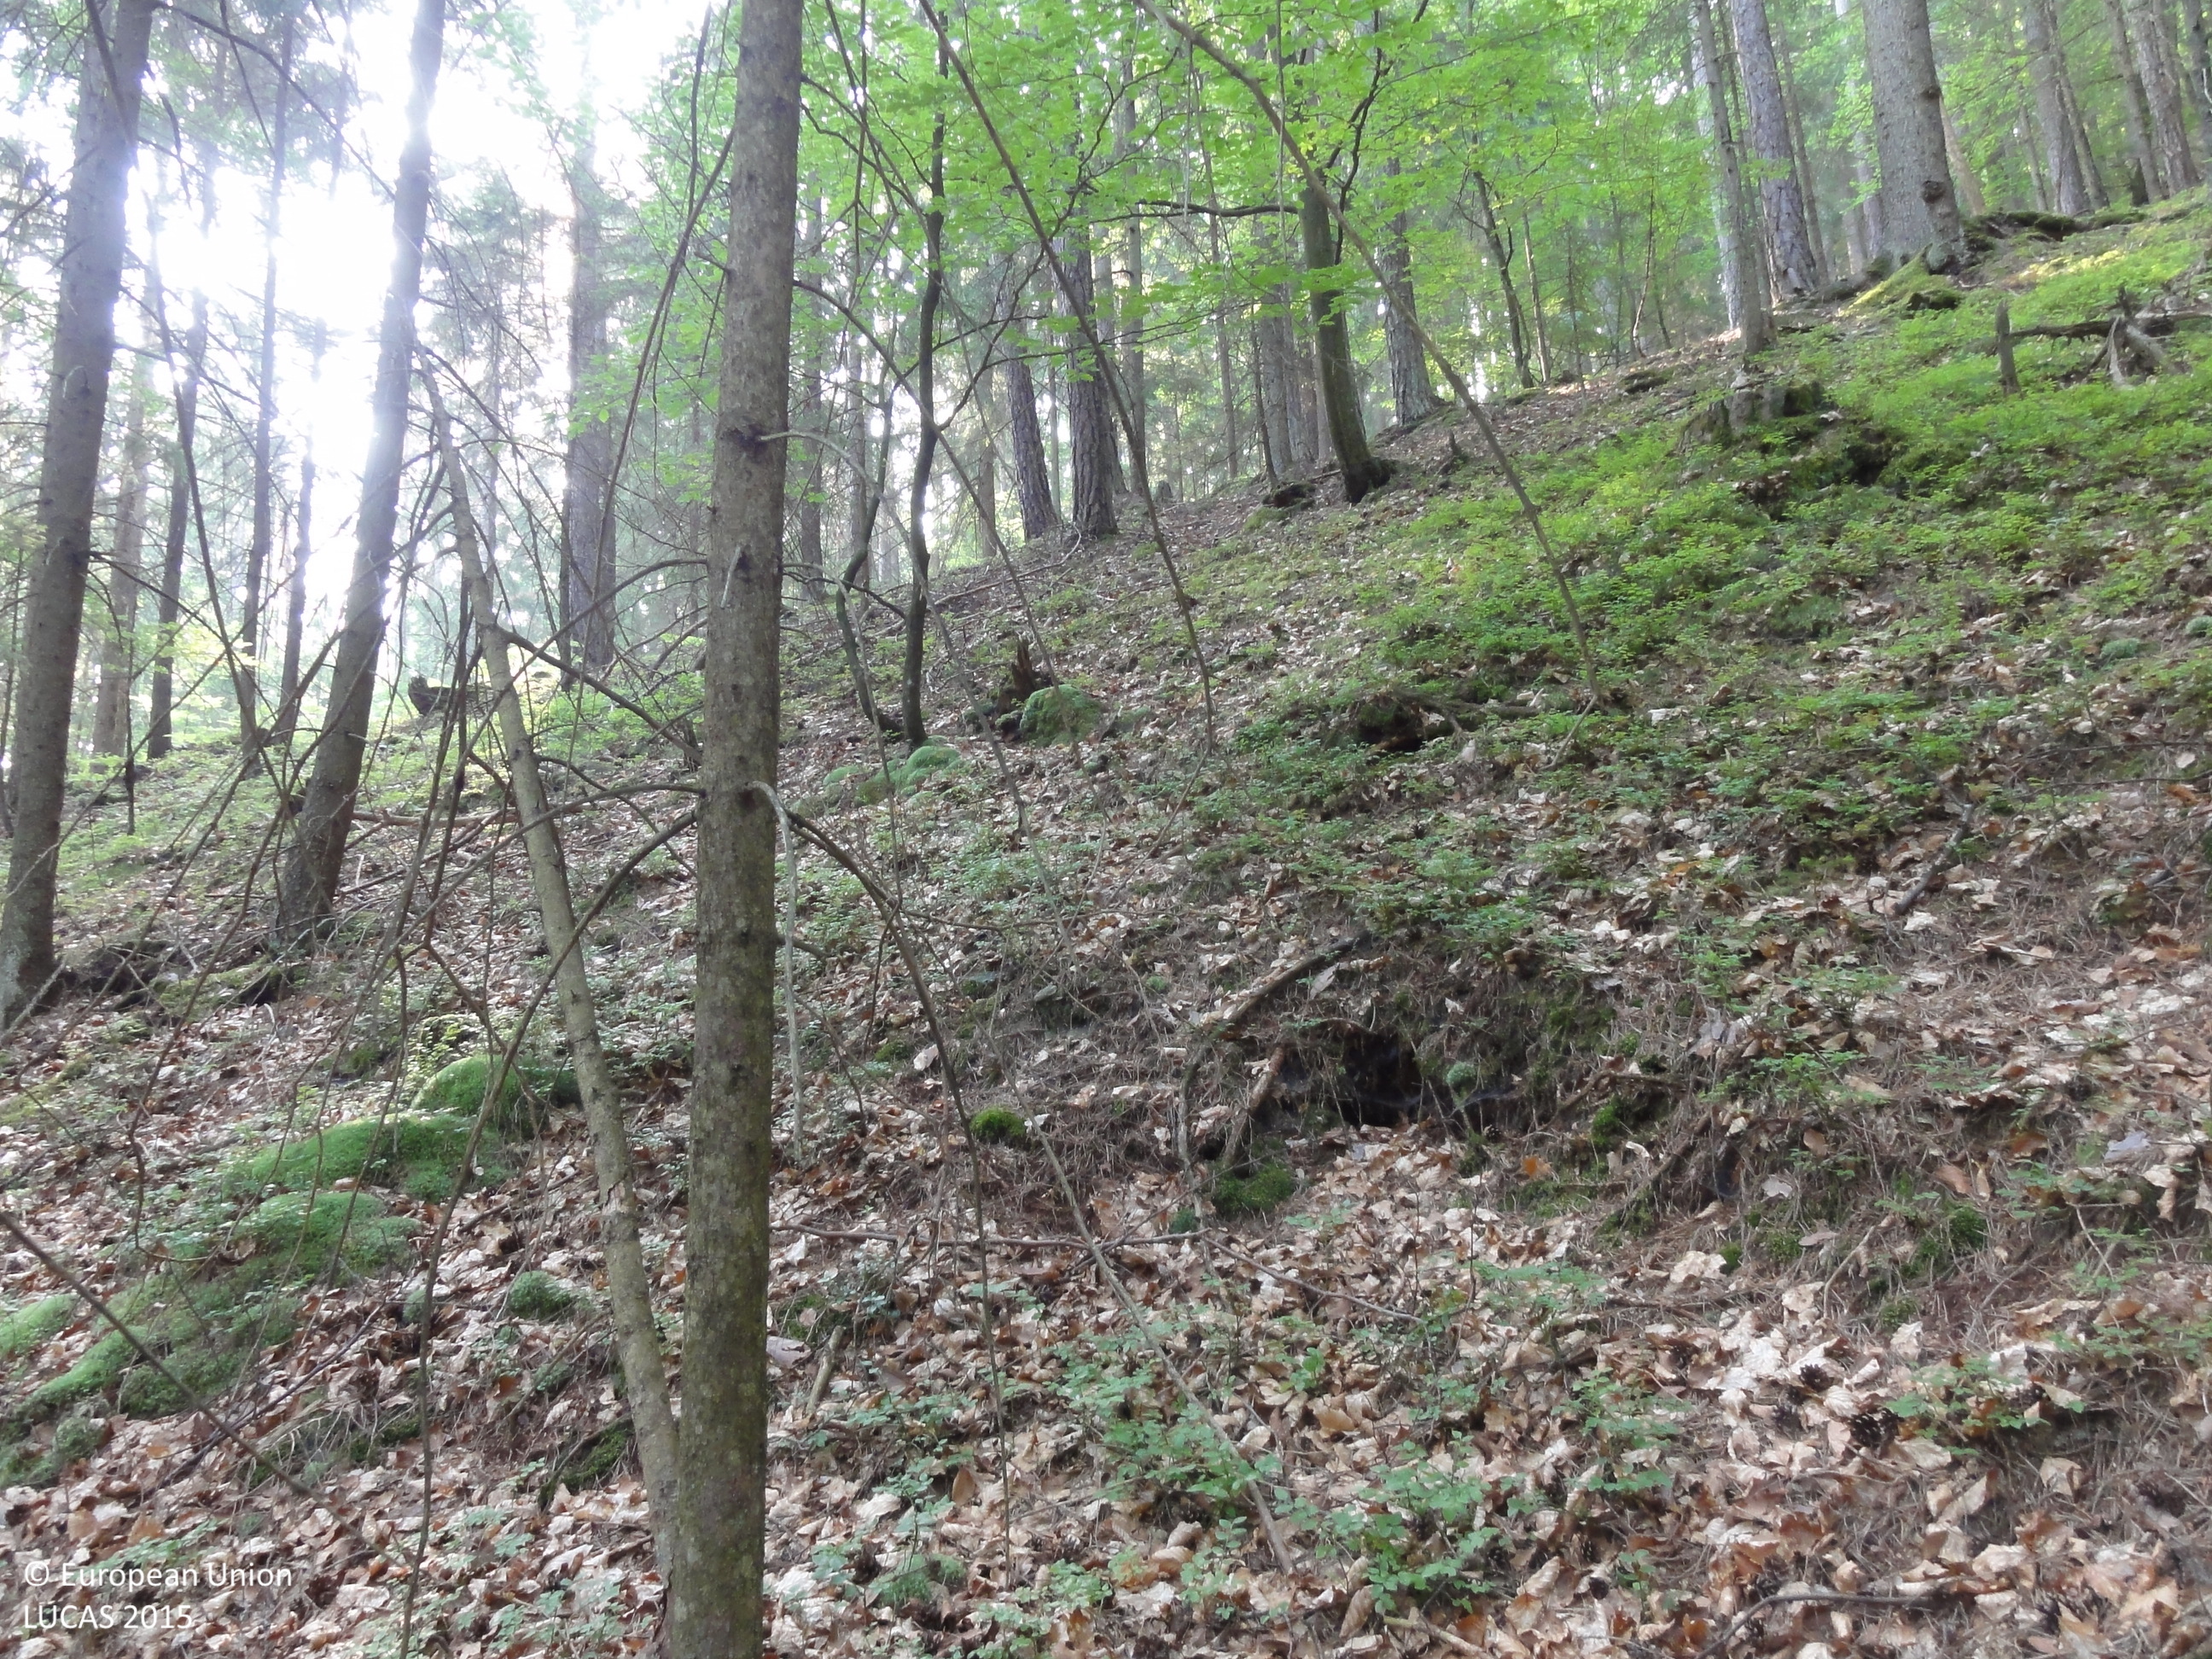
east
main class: Woodland
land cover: Other mixed woodland
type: mountainous beech forest
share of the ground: > 75 %
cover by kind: coniferous forest trees 60 %, broadleaved forest trees 40 %
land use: Forestry
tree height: > 5 m
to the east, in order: Other mixed woodland; Spruce dominated coniferous woodland; Spruce dominated mixed woodland; Tracks; Spruce dominated mixed woodland; Rivers and streams; Spruce dominated mixed woodland; Rivers and streams; Spruce dominated mixed woodland; Spruce dominated coniferous woodland; Other mixed woodland
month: July
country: SI
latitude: 46.6169
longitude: 14.9210
